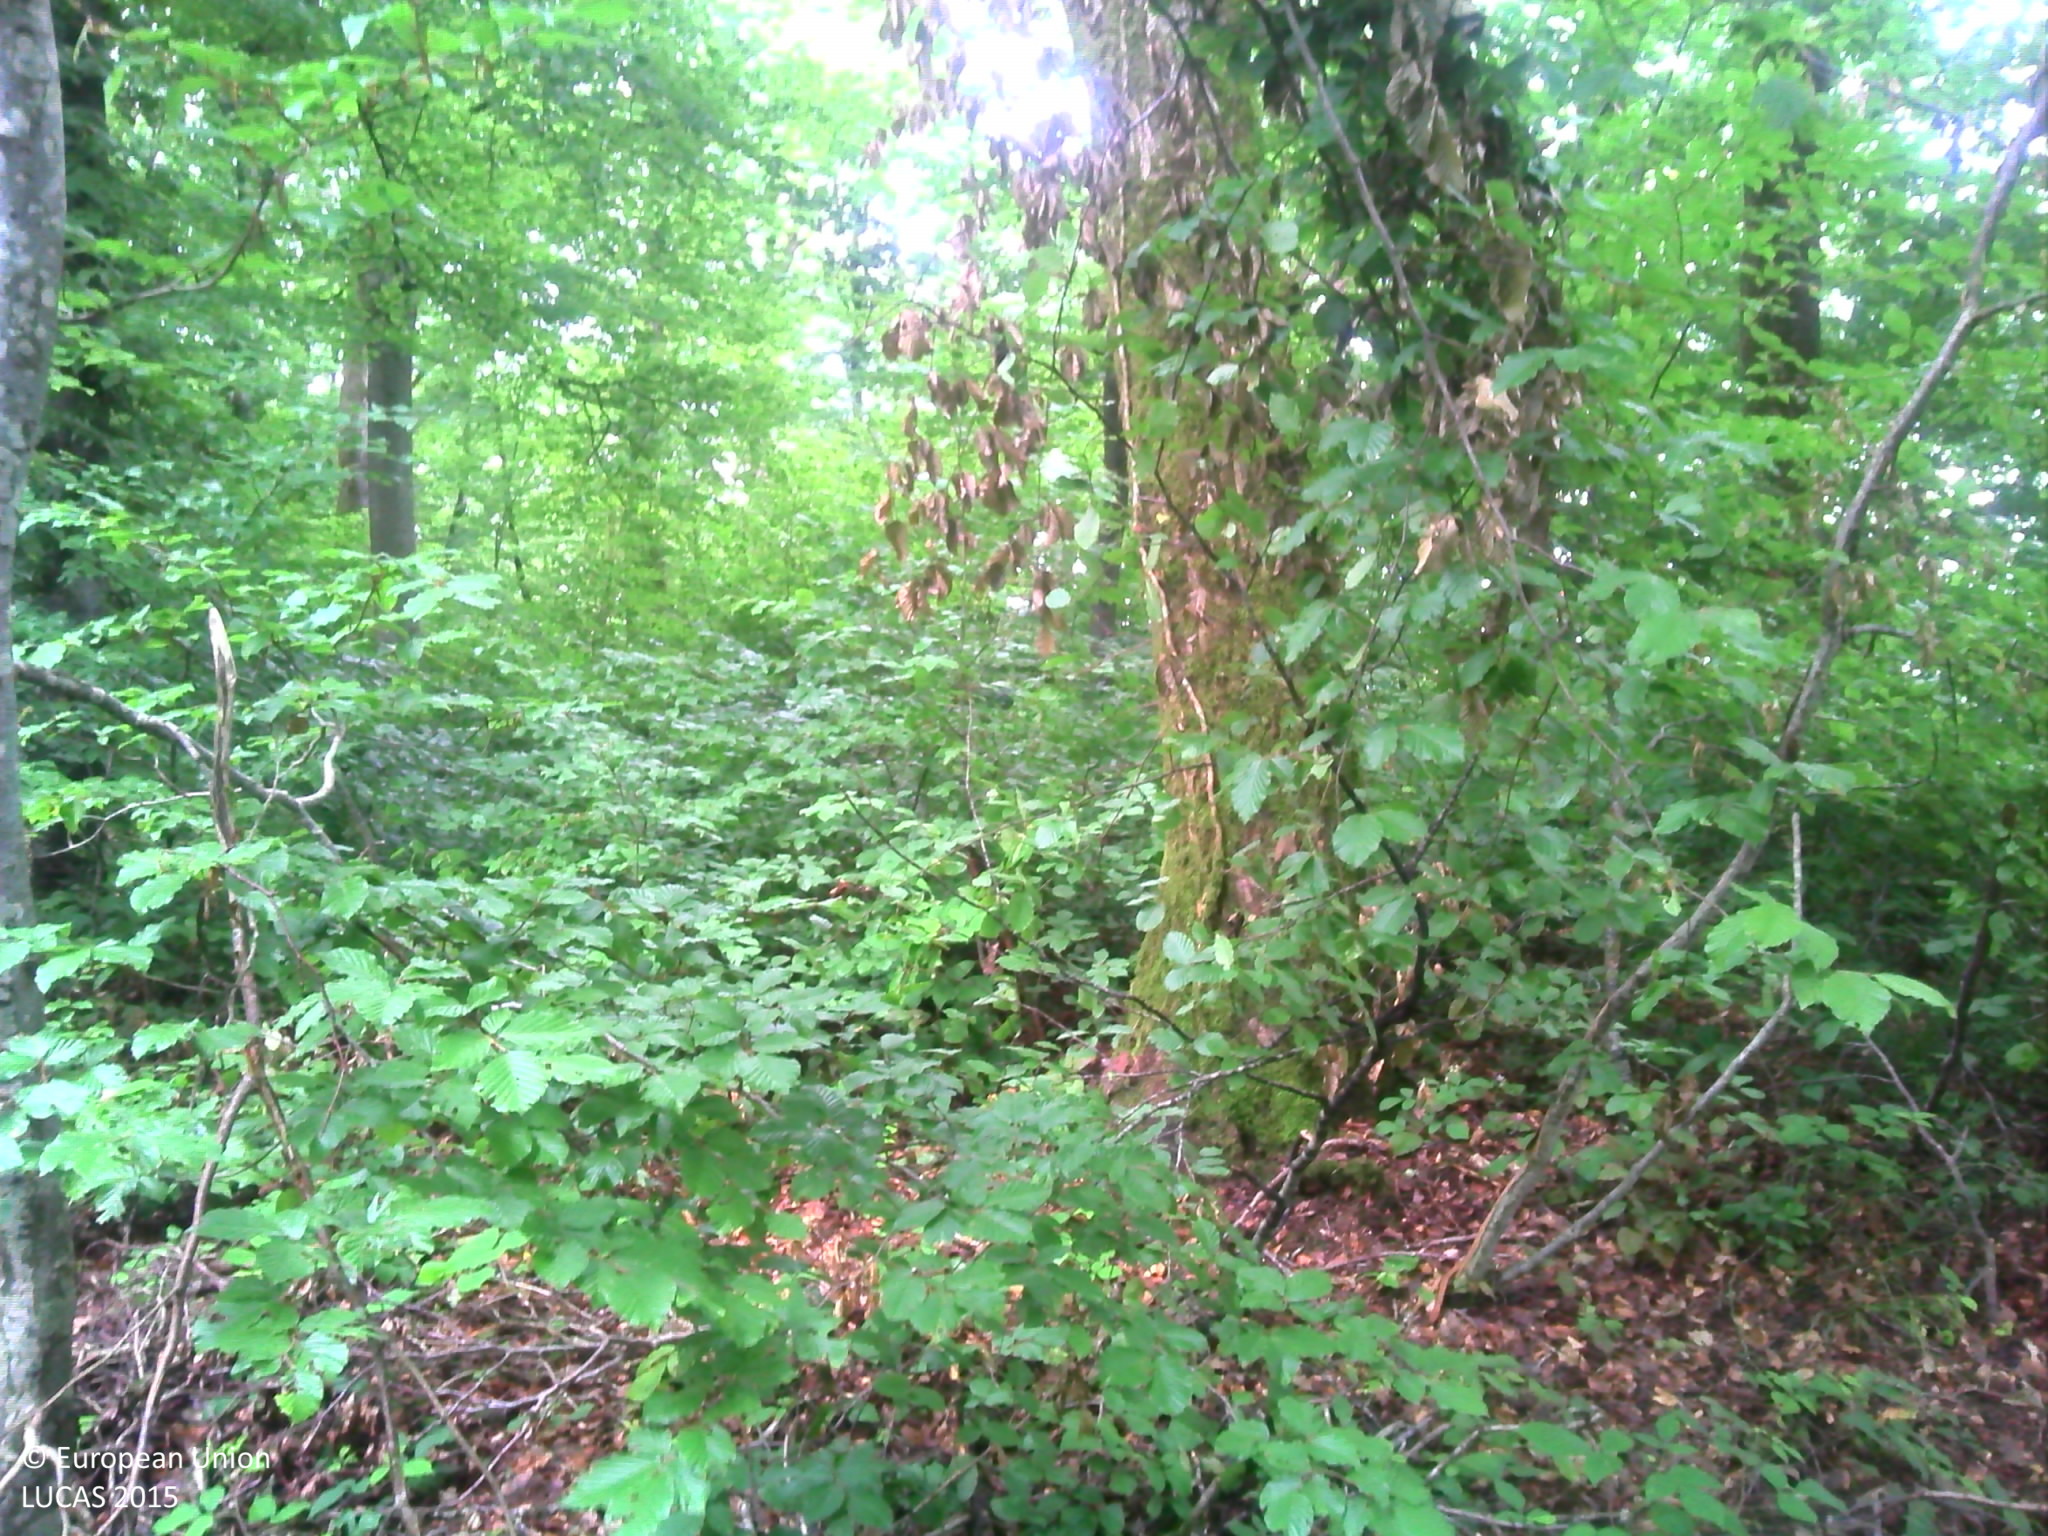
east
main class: Woodland
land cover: Broadleaved woodland
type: beech forest
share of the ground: > 75 %
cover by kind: broadleaved forest trees 90 %, shrubs 5 %, herbaceous plants 5 %
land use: Forestry
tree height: > 5 m
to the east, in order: Broadleaved woodland; Tracks; Grass margins; Tracks; Broadleaved woodland; Tracks; Grass margins; Shrubland with sparse tree cover; Broadleaved woodland; Ditches and canals; Broadleaved woodland
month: June
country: FR
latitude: 47.6772
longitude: 6.3650
